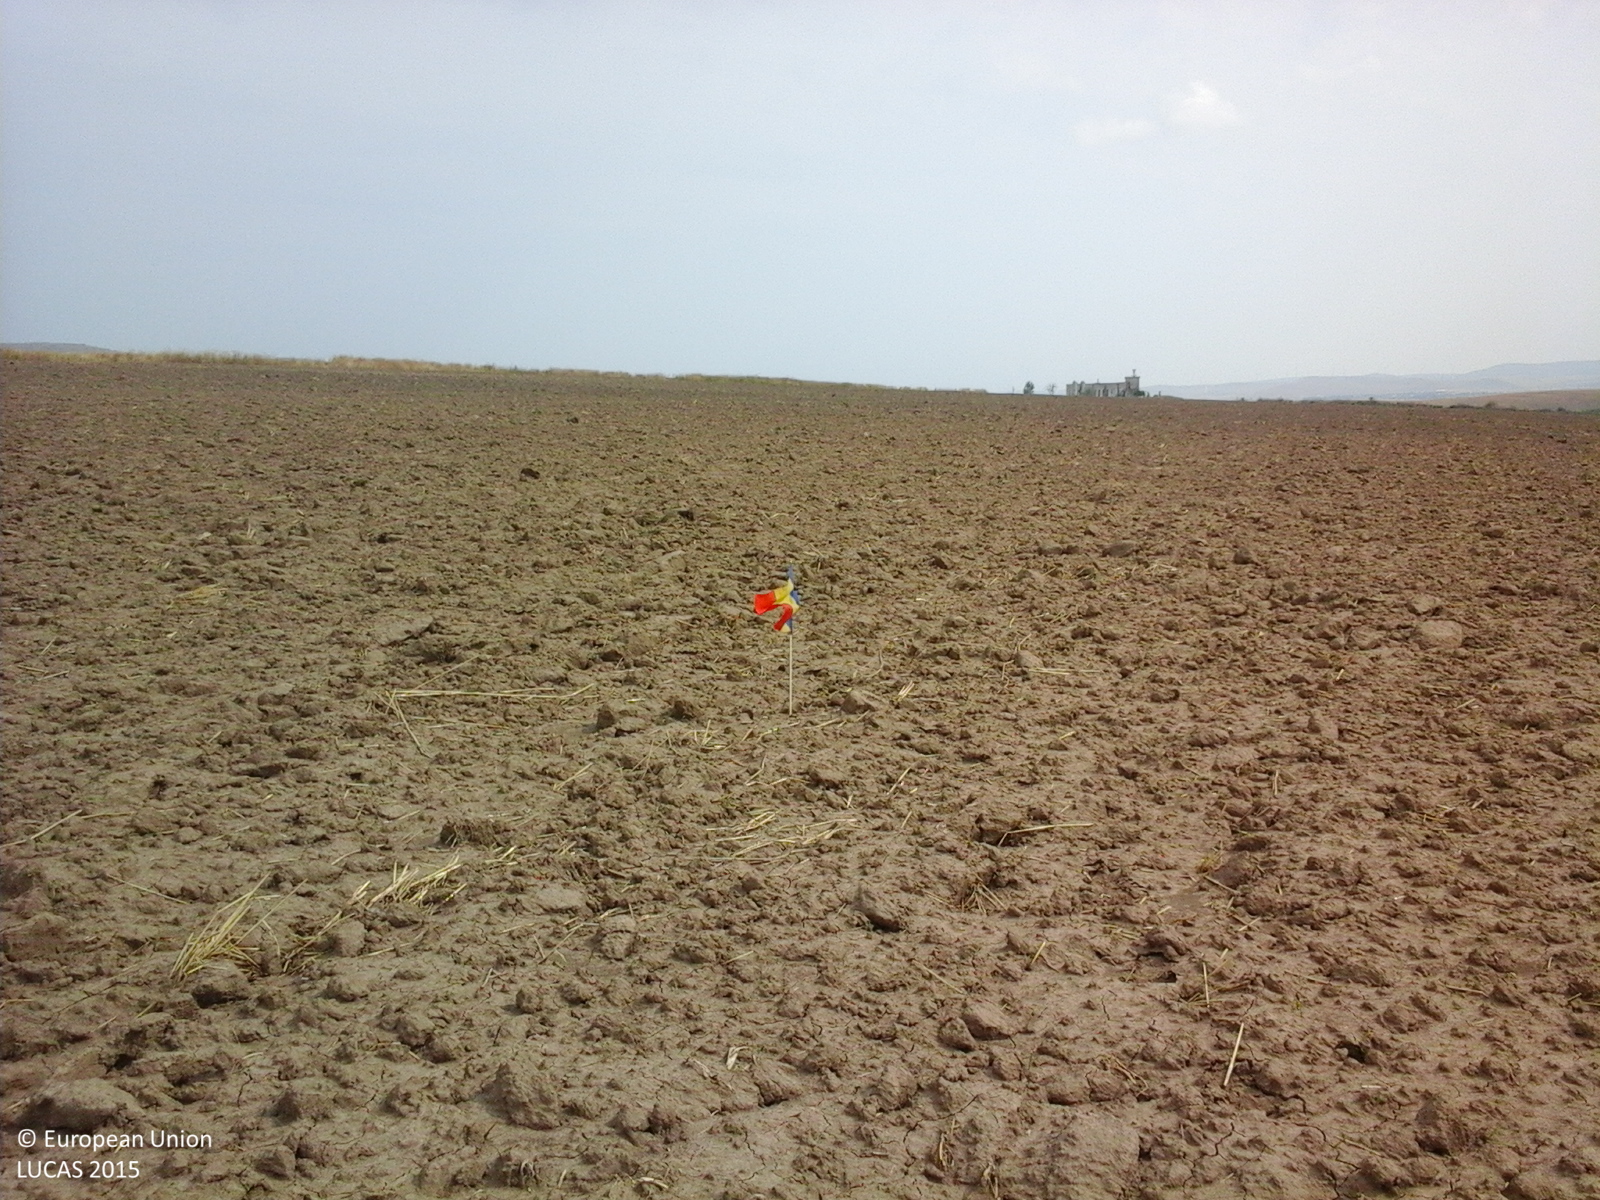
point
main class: Cropland
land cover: Oats
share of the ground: < 10 %
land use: Agriculture (excluding fallow land and kitchen gardens)
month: July
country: RO
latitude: 45.0241
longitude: 28.6506
